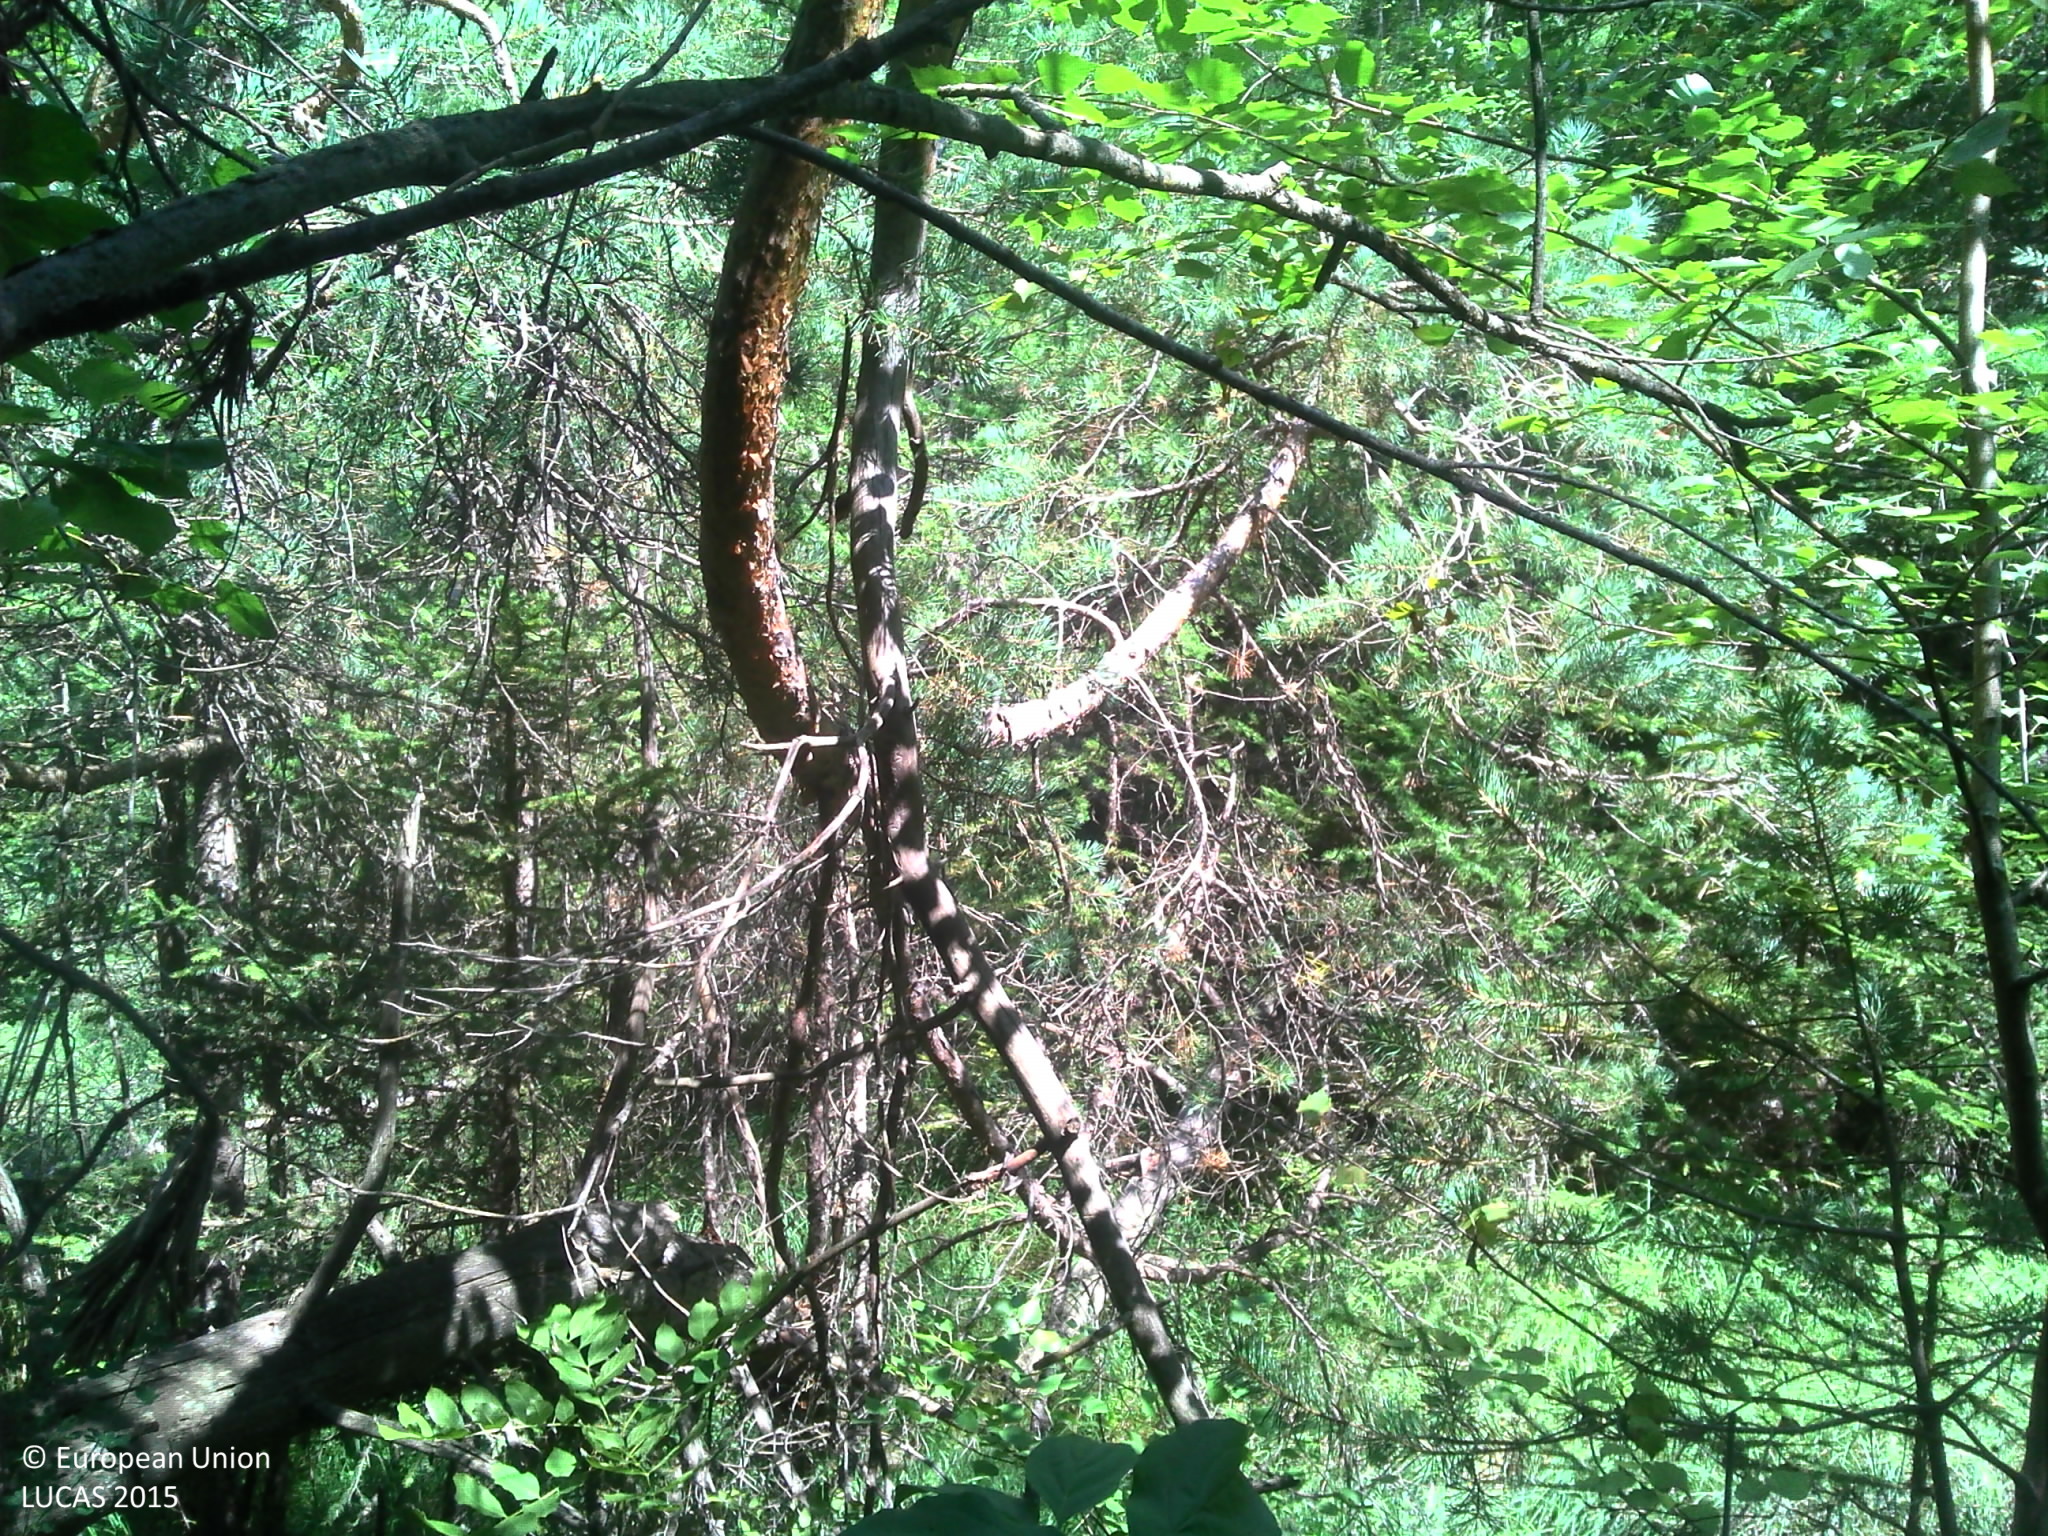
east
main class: Woodland
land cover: Pine dominated mixed woodland
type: alpine coniferous forest
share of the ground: > 75 %
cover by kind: coniferous forest trees 40 %, broadleaved forest trees 40 %, shrubs 10 %, herbaceous plants 10 %
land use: Forestry
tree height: > 5 m
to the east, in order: Pine dominated mixed woodland; Rivers and streams; Grass margins; Pine dominated mixed woodland; Grassland without tree/shrub cover; Broadleaved woodland; Grassland without tree/shrub cover; Broadleaved woodland
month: August
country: FR
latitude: 44.3845
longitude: 6.5798
